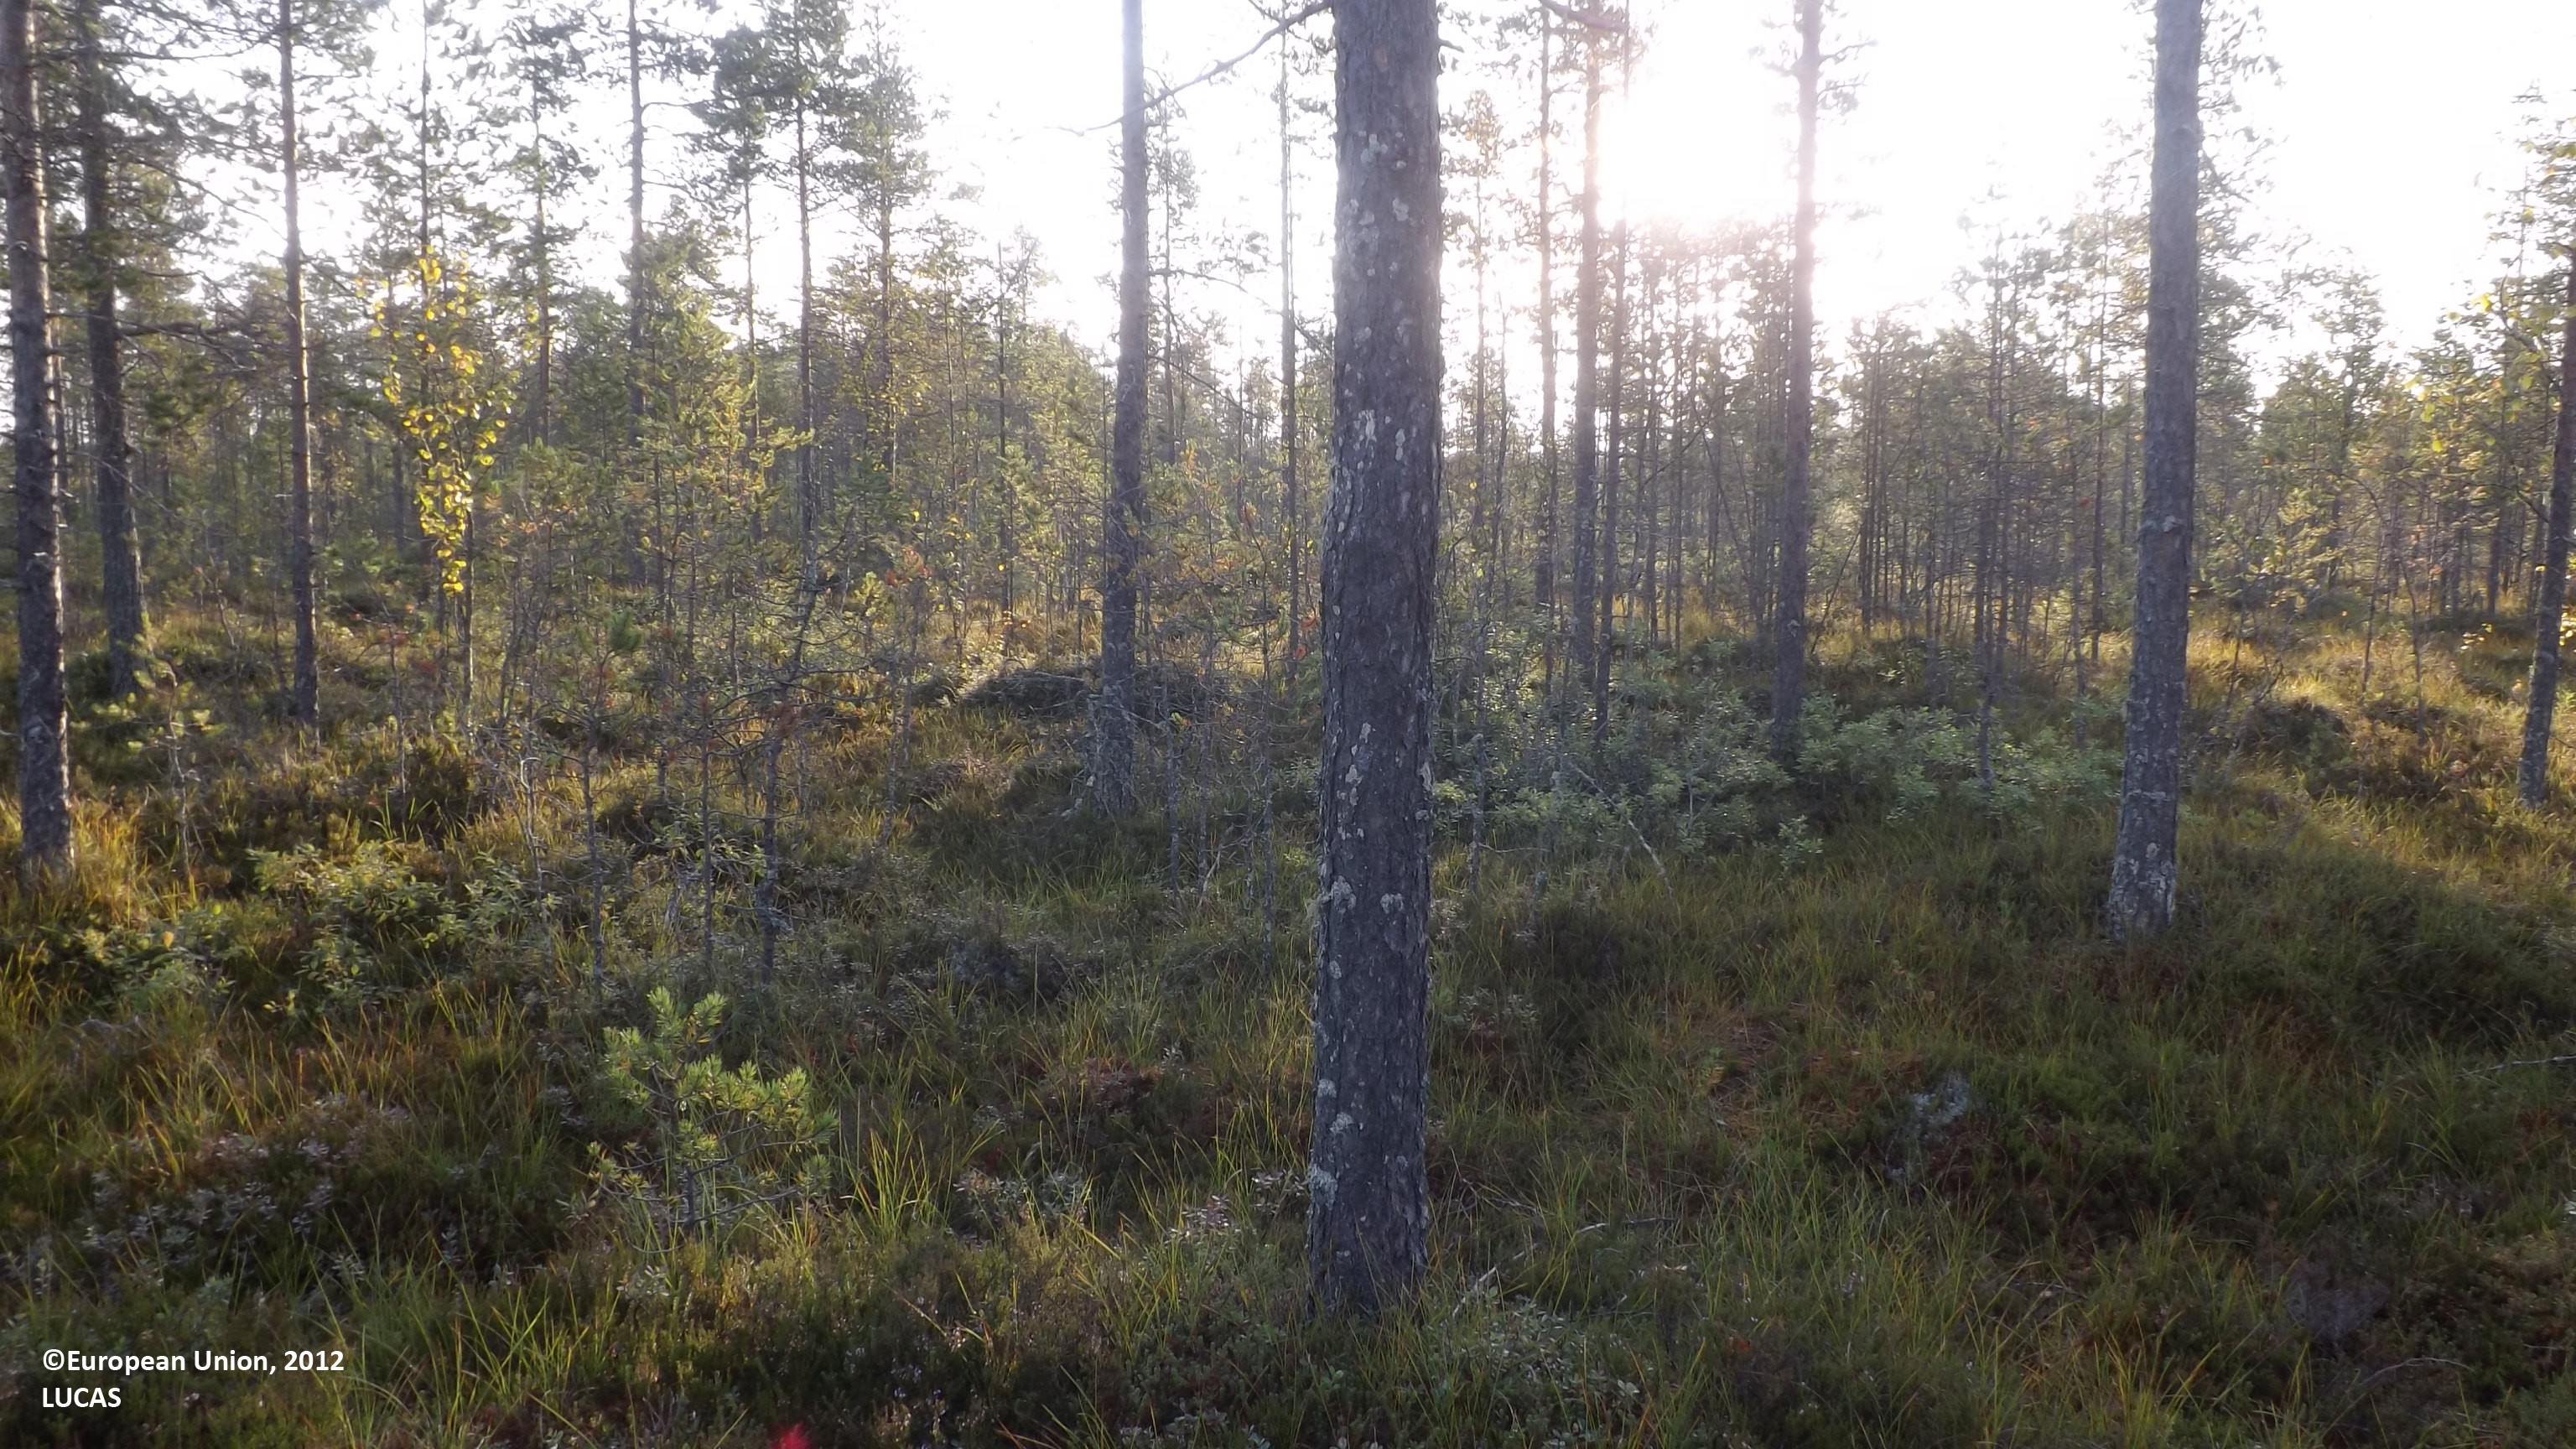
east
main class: Woodland
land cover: Pine dominated coniferous woodland
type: mire and swamp forests
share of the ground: 10 - 25 %
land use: Forestry
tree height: < 5 m
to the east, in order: Pine dominated coniferous woodland; Broadleaved woodland
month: August
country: FI
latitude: 63.8015
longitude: 24.0979
